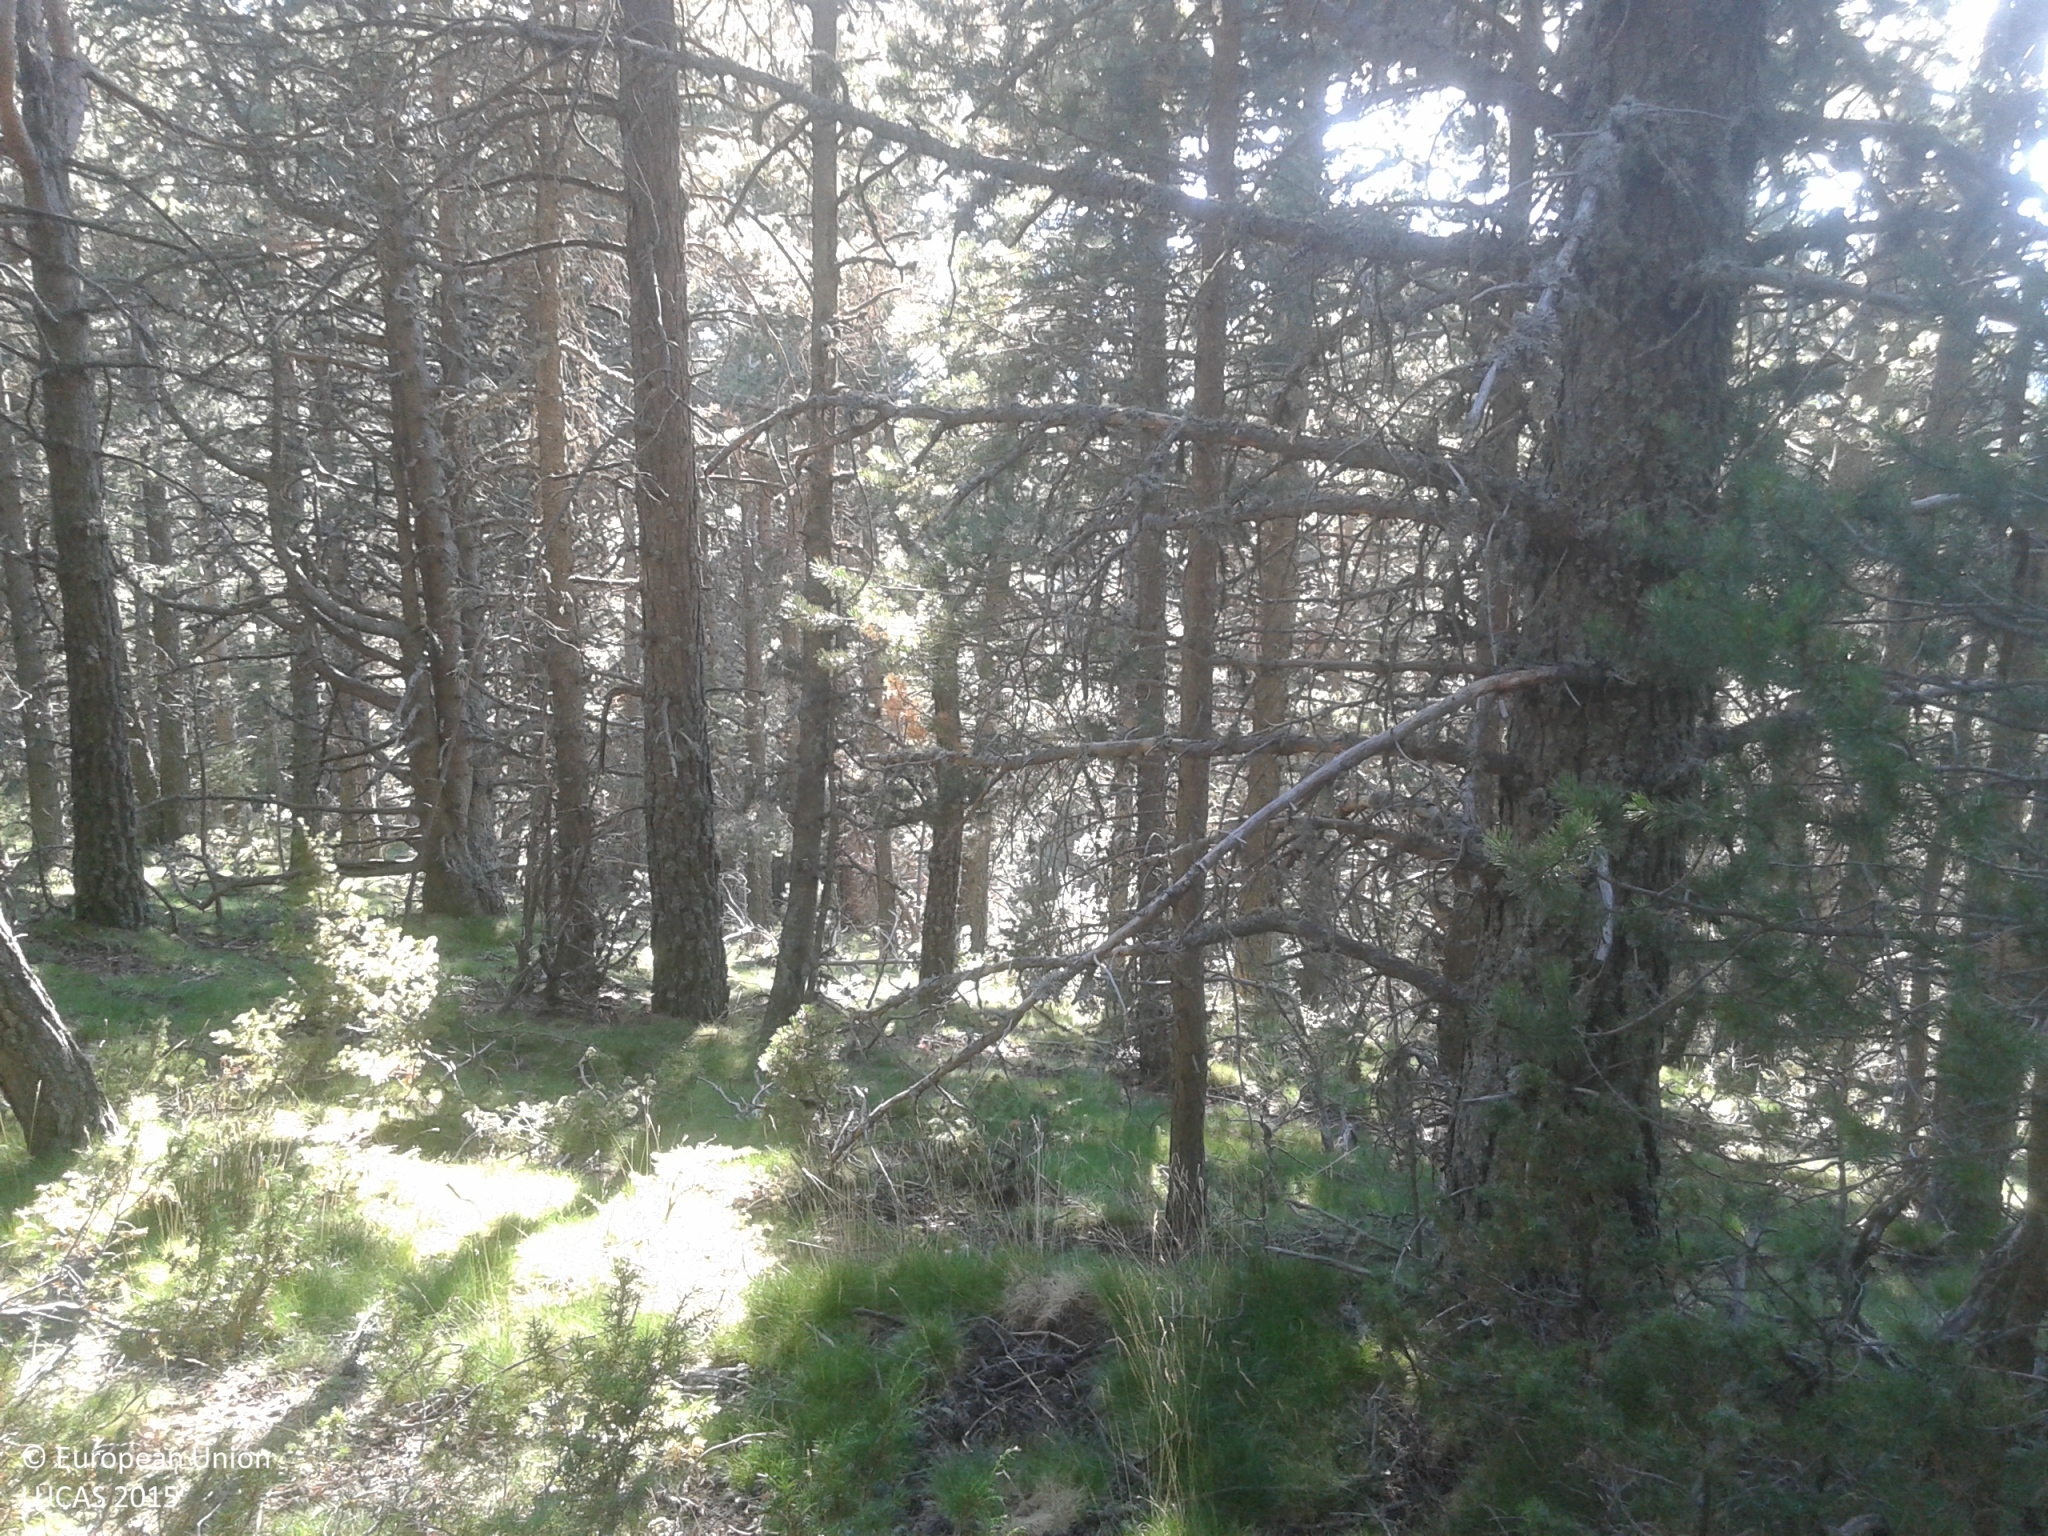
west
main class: Woodland
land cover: Pine dominated coniferous woodland
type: alpine coniferous forest
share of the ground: > 75 %
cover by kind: coniferous forest trees 80 %, herbaceous plants 15 %, shrubs 5 %
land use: Semi-natural and natural areas not in use
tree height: > 5 m
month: July
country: ES
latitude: 42.2810
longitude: 1.5345
